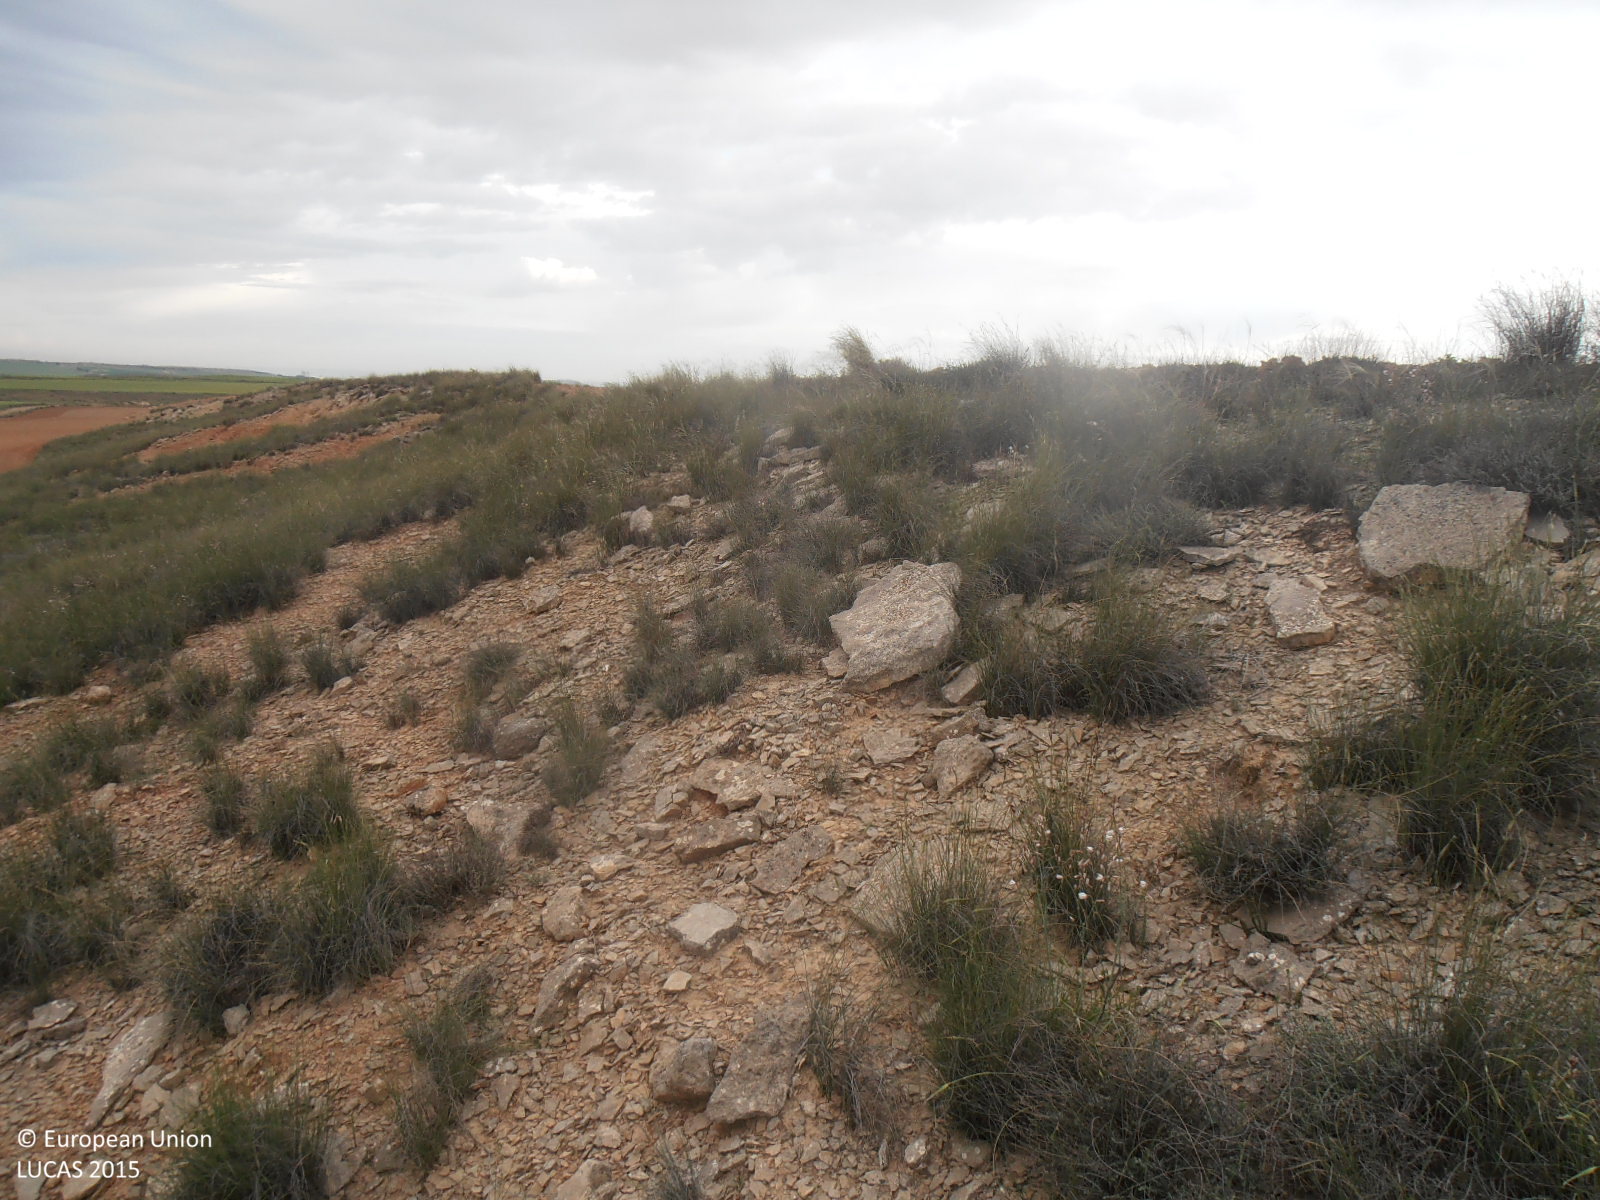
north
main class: Shrubland
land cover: Shrubland without tree cover
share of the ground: 50 - 75 %
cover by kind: shrubs 50 %, herbaceous plants 25 %, consolidated bare surface 25 %
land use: Semi-natural and natural areas not in use
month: April
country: ES
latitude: 41.3883
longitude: -0.4084
